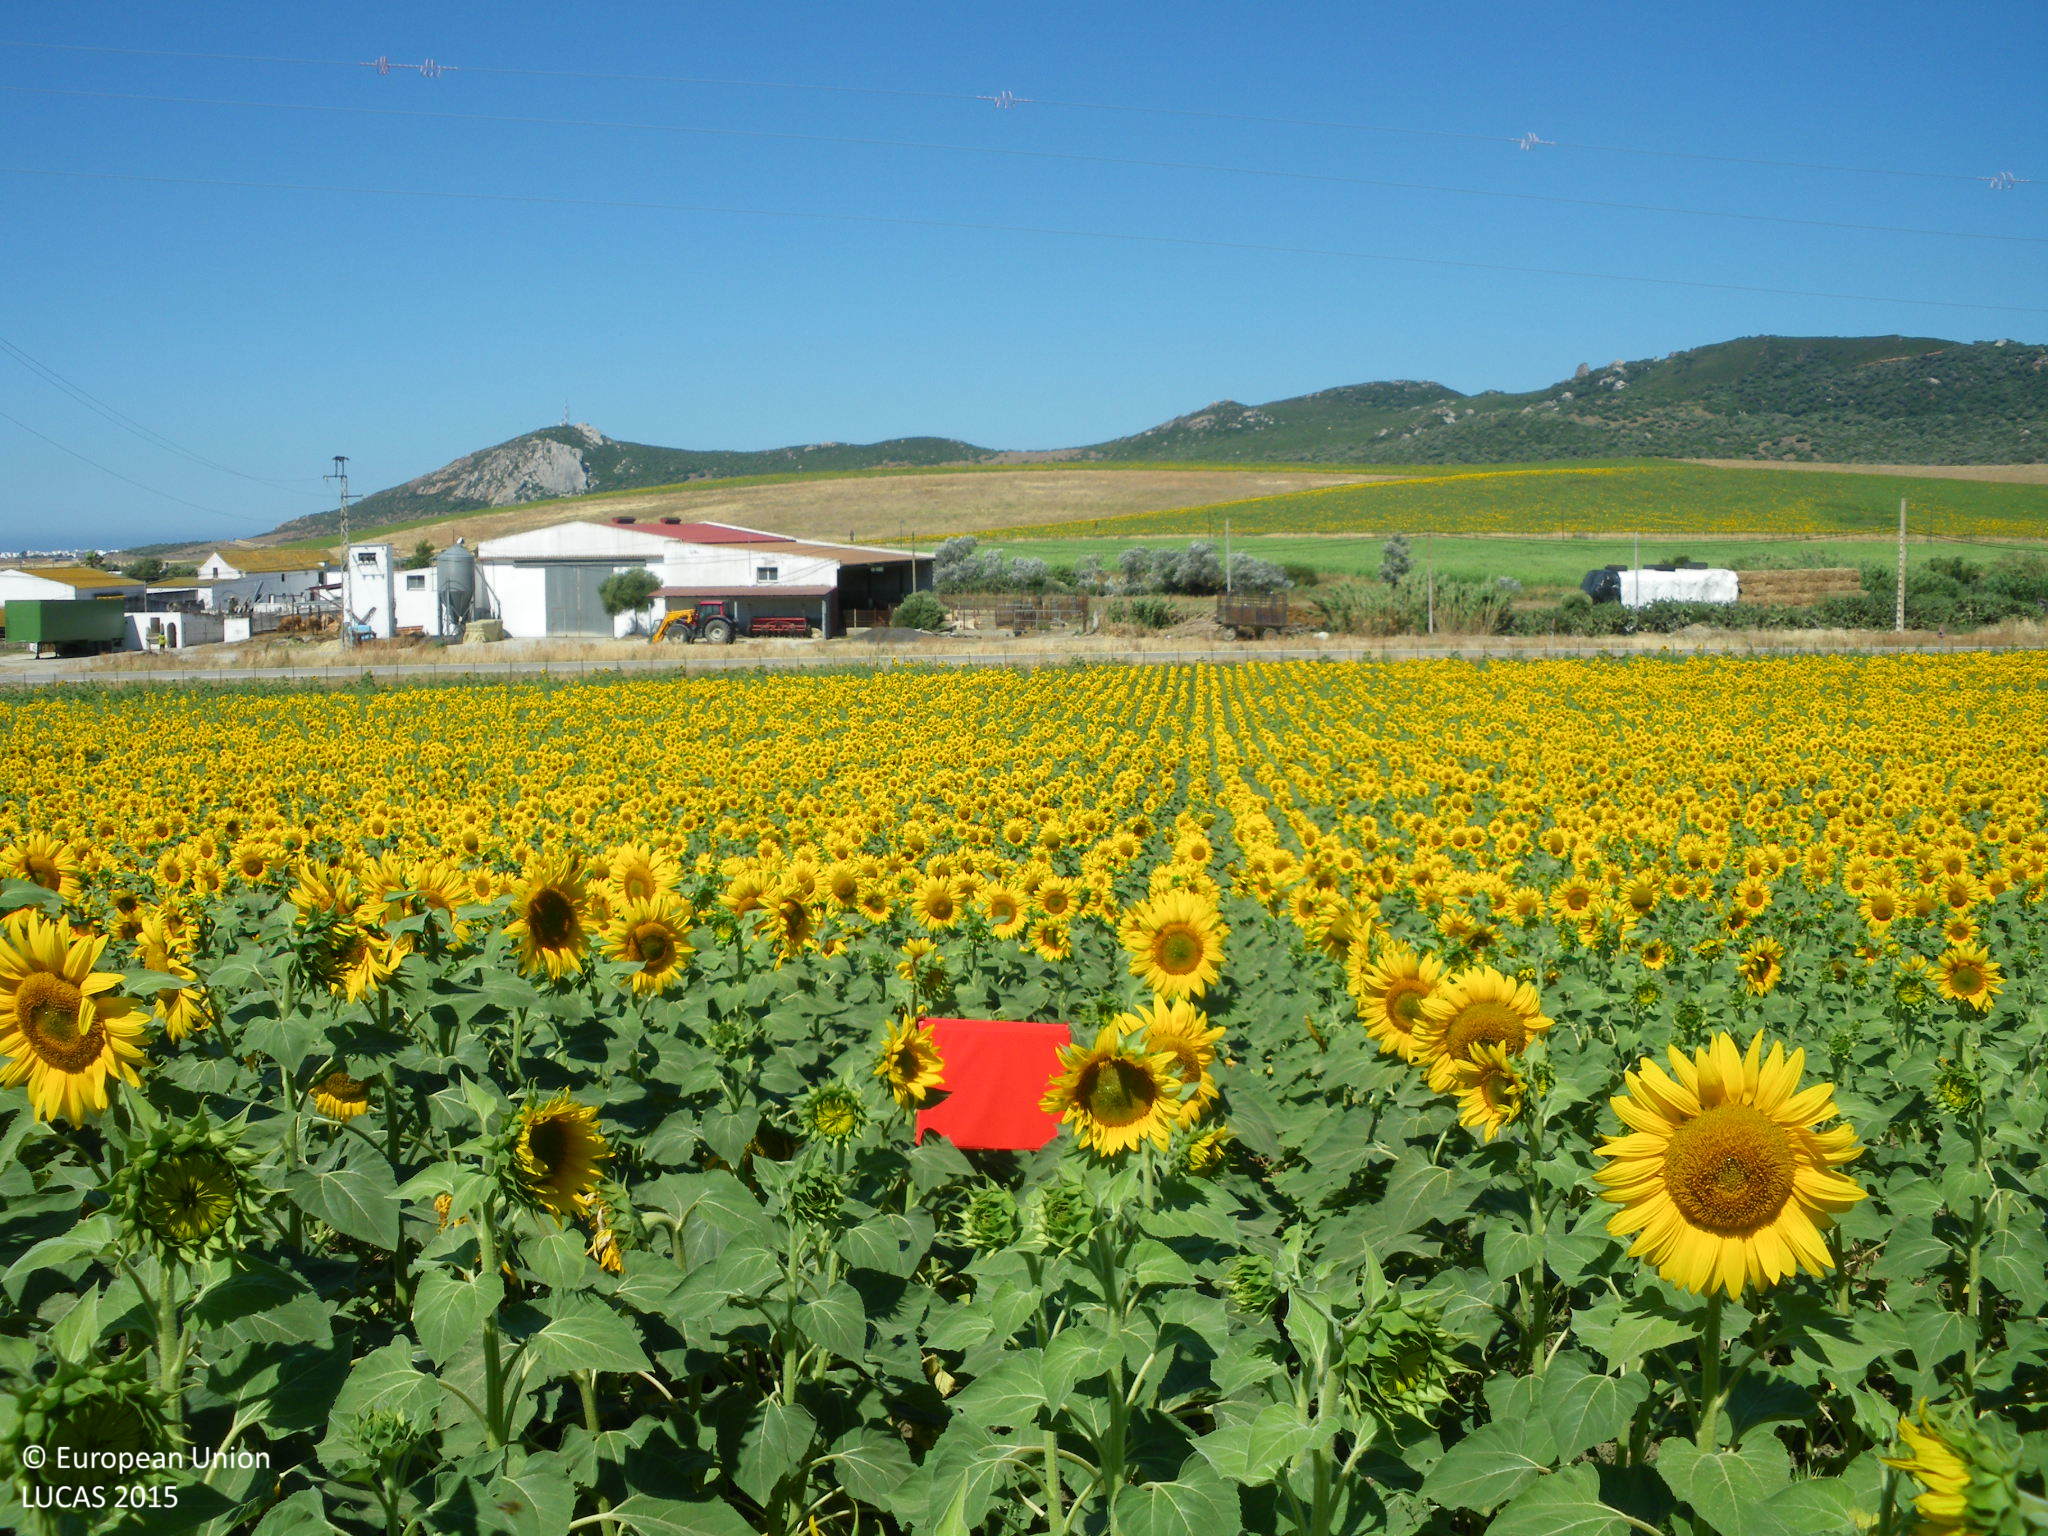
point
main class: Cropland
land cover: Sunflower
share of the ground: > 75 %
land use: Agriculture (excluding fallow land and kitchen gardens)
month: June
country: ES
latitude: 36.1570
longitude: -5.8140
